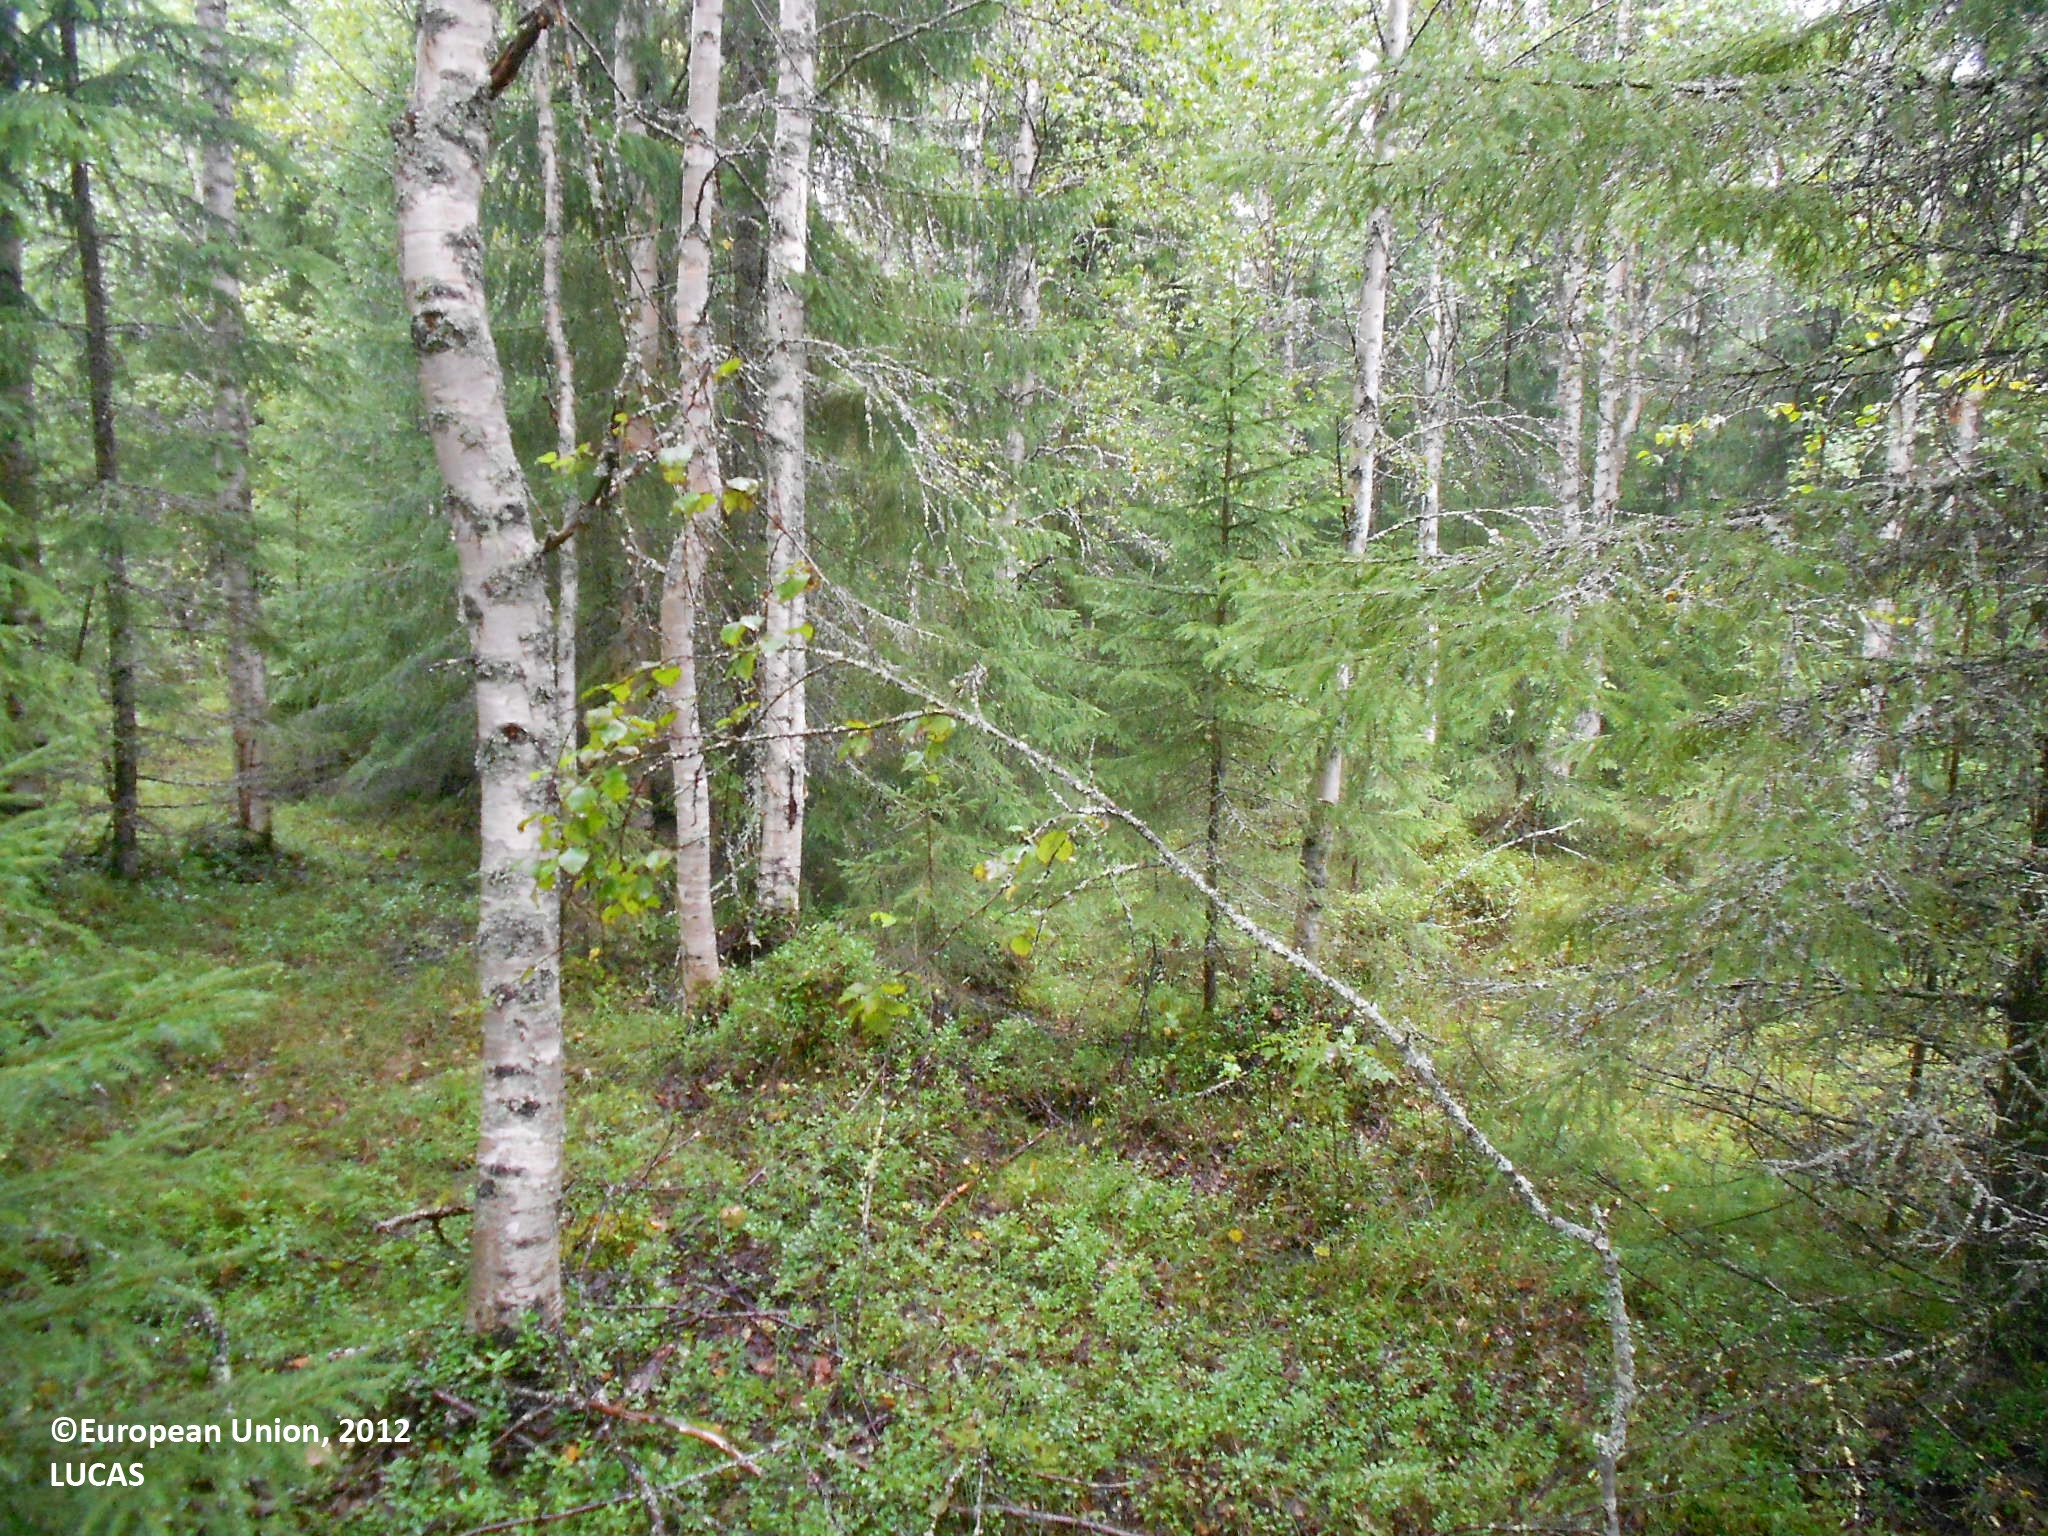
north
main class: Woodland
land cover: Spruce dominated mixed woodland
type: boreal forest
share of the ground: > 75 %
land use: Forestry
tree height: > 5 m
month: August
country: FI
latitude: 63.9689
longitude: 28.1644
